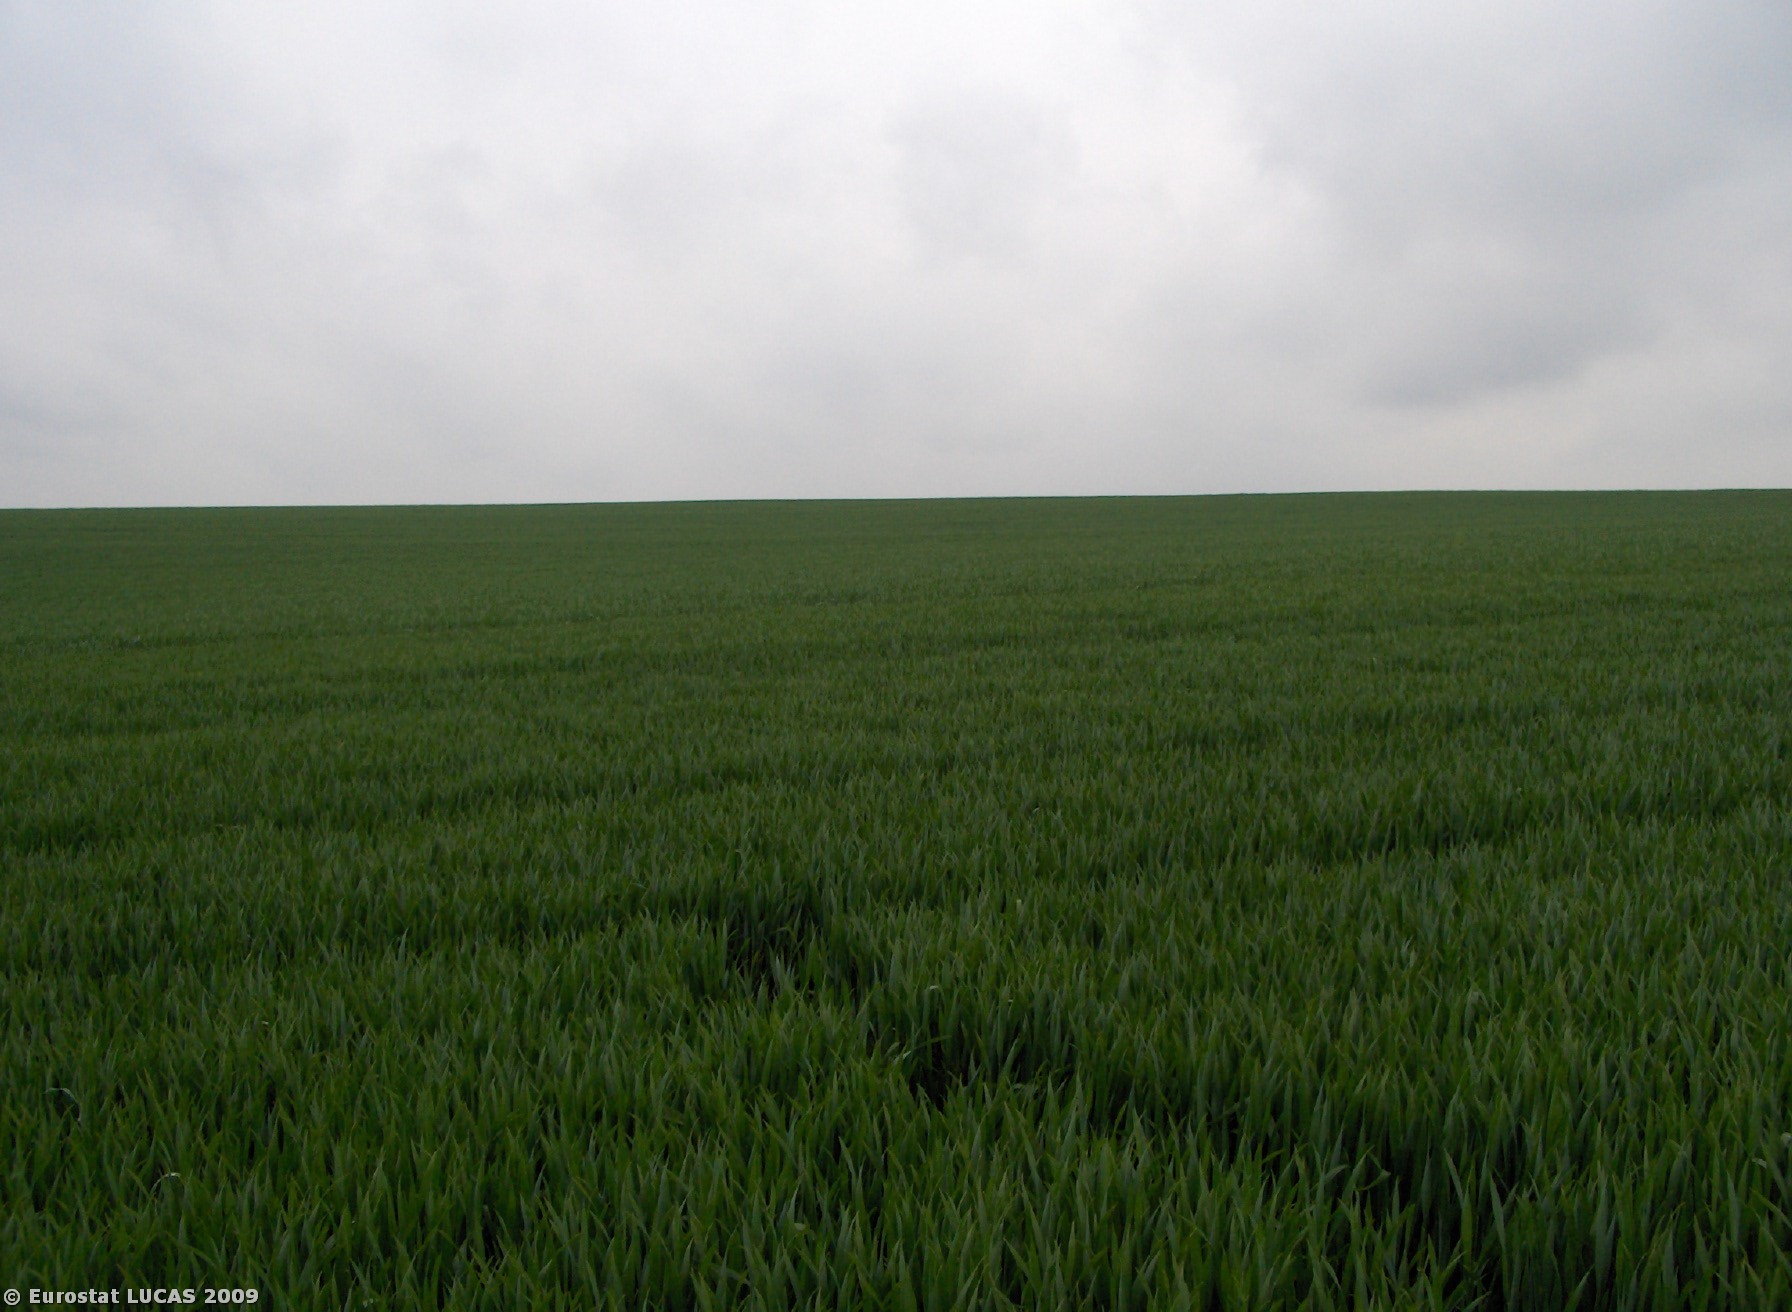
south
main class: Cropland
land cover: Common wheat
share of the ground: > 75 %
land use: Agriculture (excluding fallow land and kitchen gardens)
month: May
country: CZ
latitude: 49.3992
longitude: 17.1617
